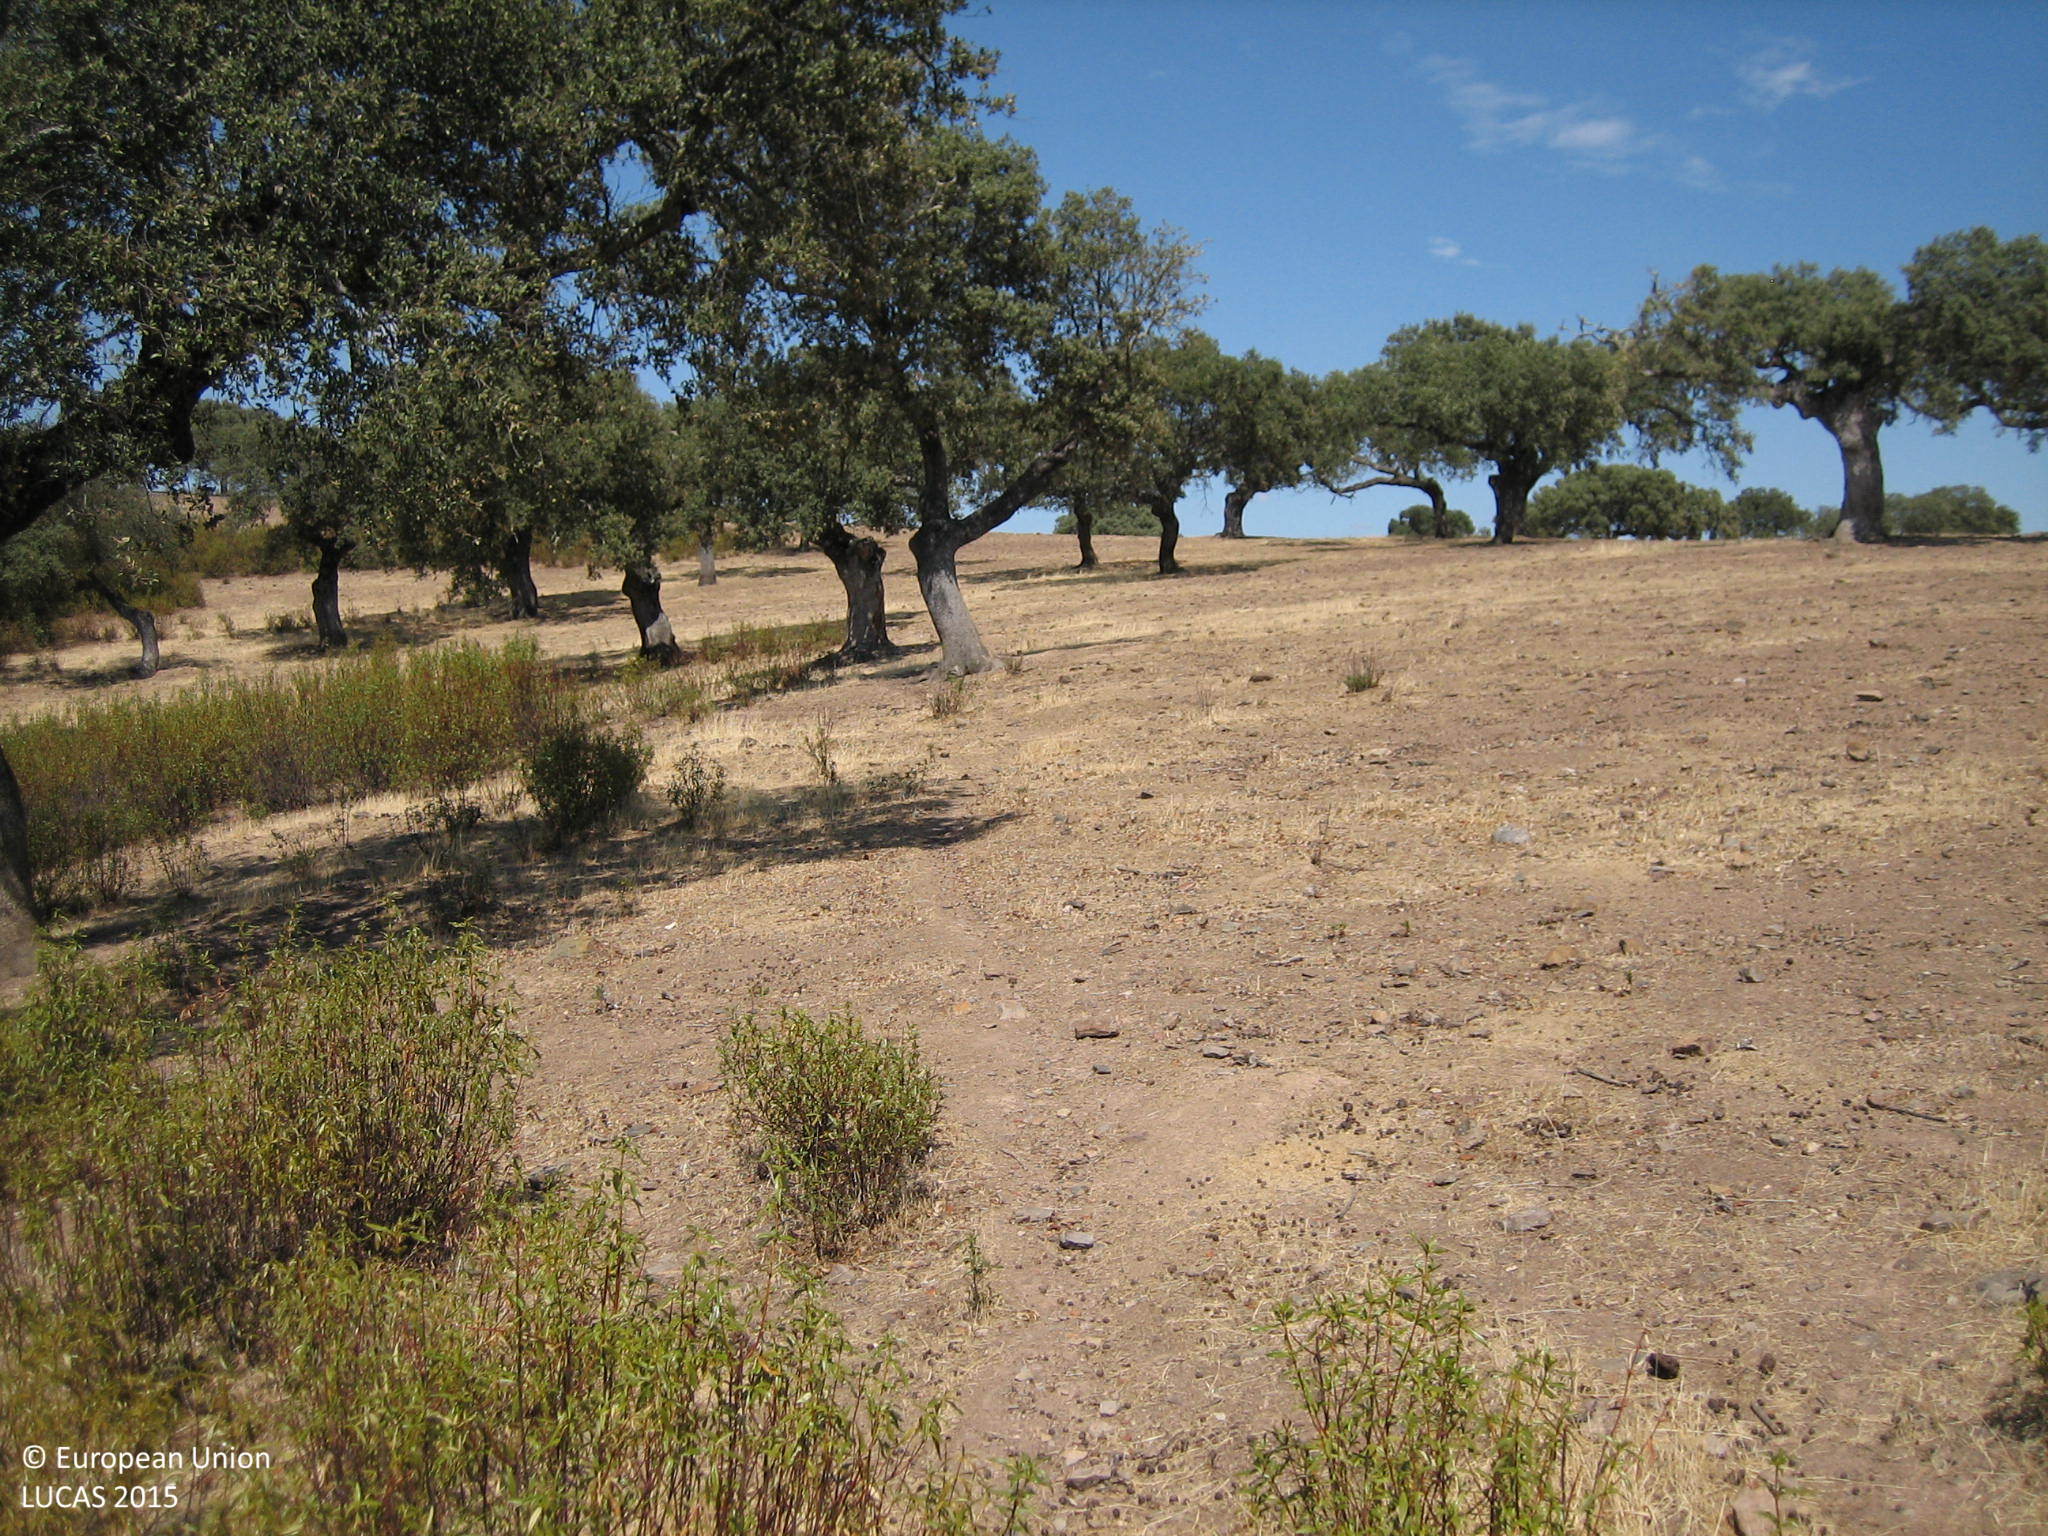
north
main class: Woodland
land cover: Broadleaved woodland
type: broadleaved evergreen forest
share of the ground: 10 - 25 %
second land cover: Grassland without tree/shrub cover
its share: 50 - 75 %
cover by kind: herbaceous plants 50 %, unconsolidated bare surface 25 %, broadleaved forest trees 20 %, shrubs 5 %
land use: Forestry
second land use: Agriculture (excluding fallow land and kitchen gardens)
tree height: > 5 m
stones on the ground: < 10 %
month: September
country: ES
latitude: 38.2023
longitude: -7.0861
